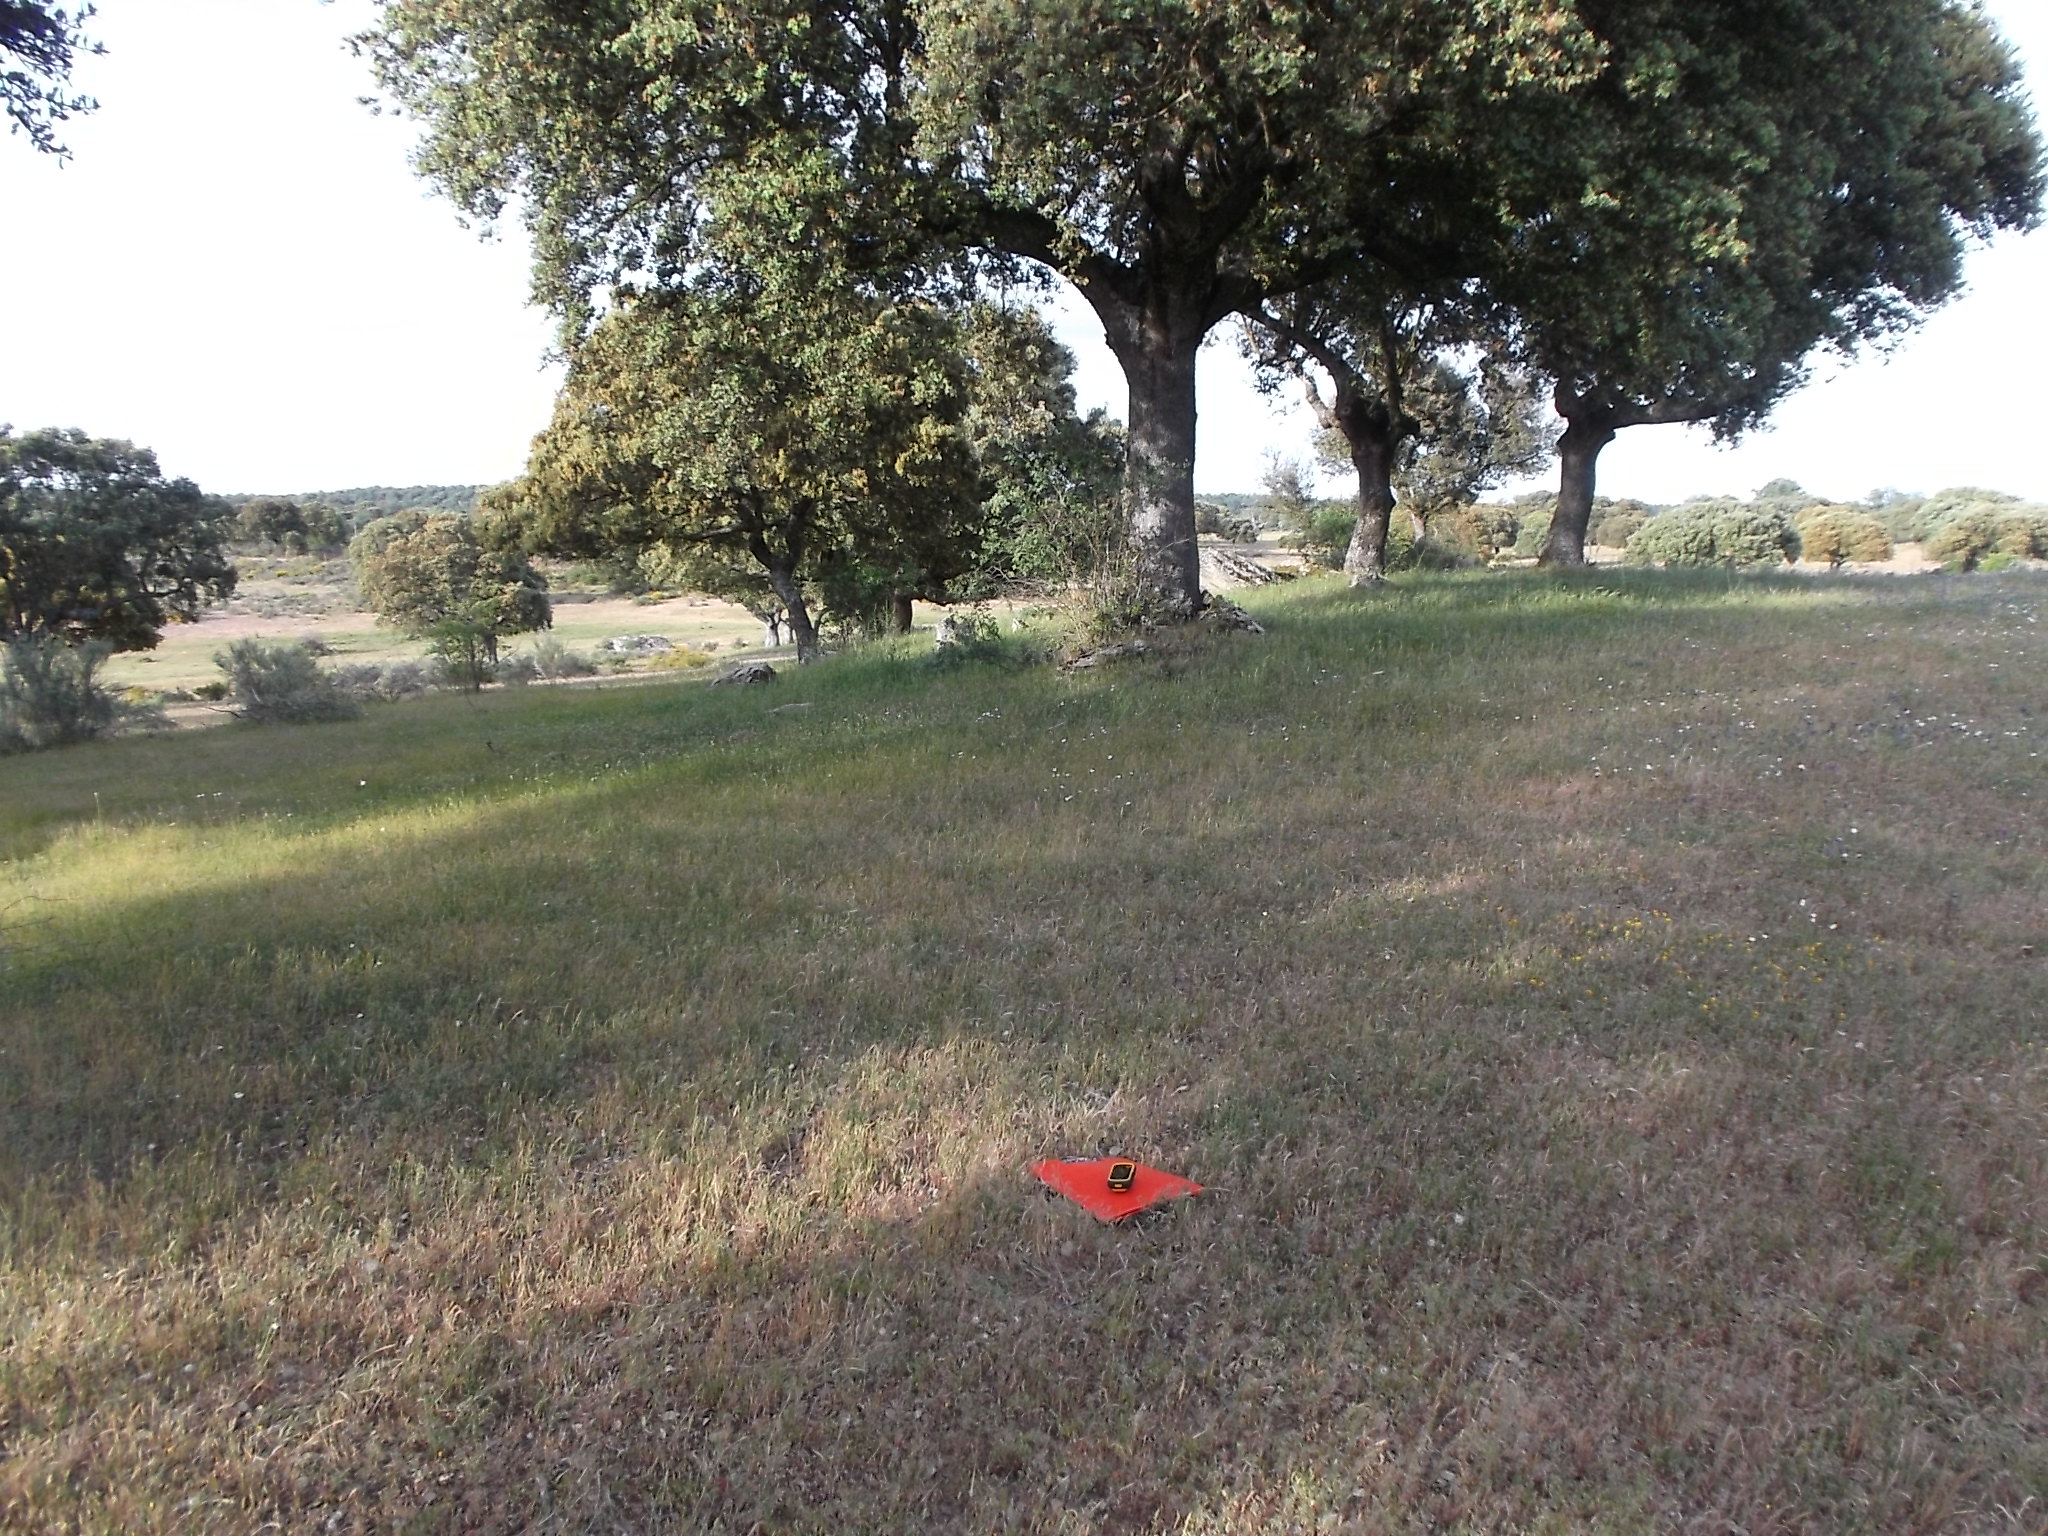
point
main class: Grassland
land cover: Grassland with sparse tree/shrub cover
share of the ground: > 75 %
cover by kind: herbaceous plants 90 %, broadleaved forest trees 5 %, shrubs 5 %
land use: Agriculture (excluding fallow land and kitchen gardens)
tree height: > 5 m
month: May
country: ES
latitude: 41.0676
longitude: -6.2884
